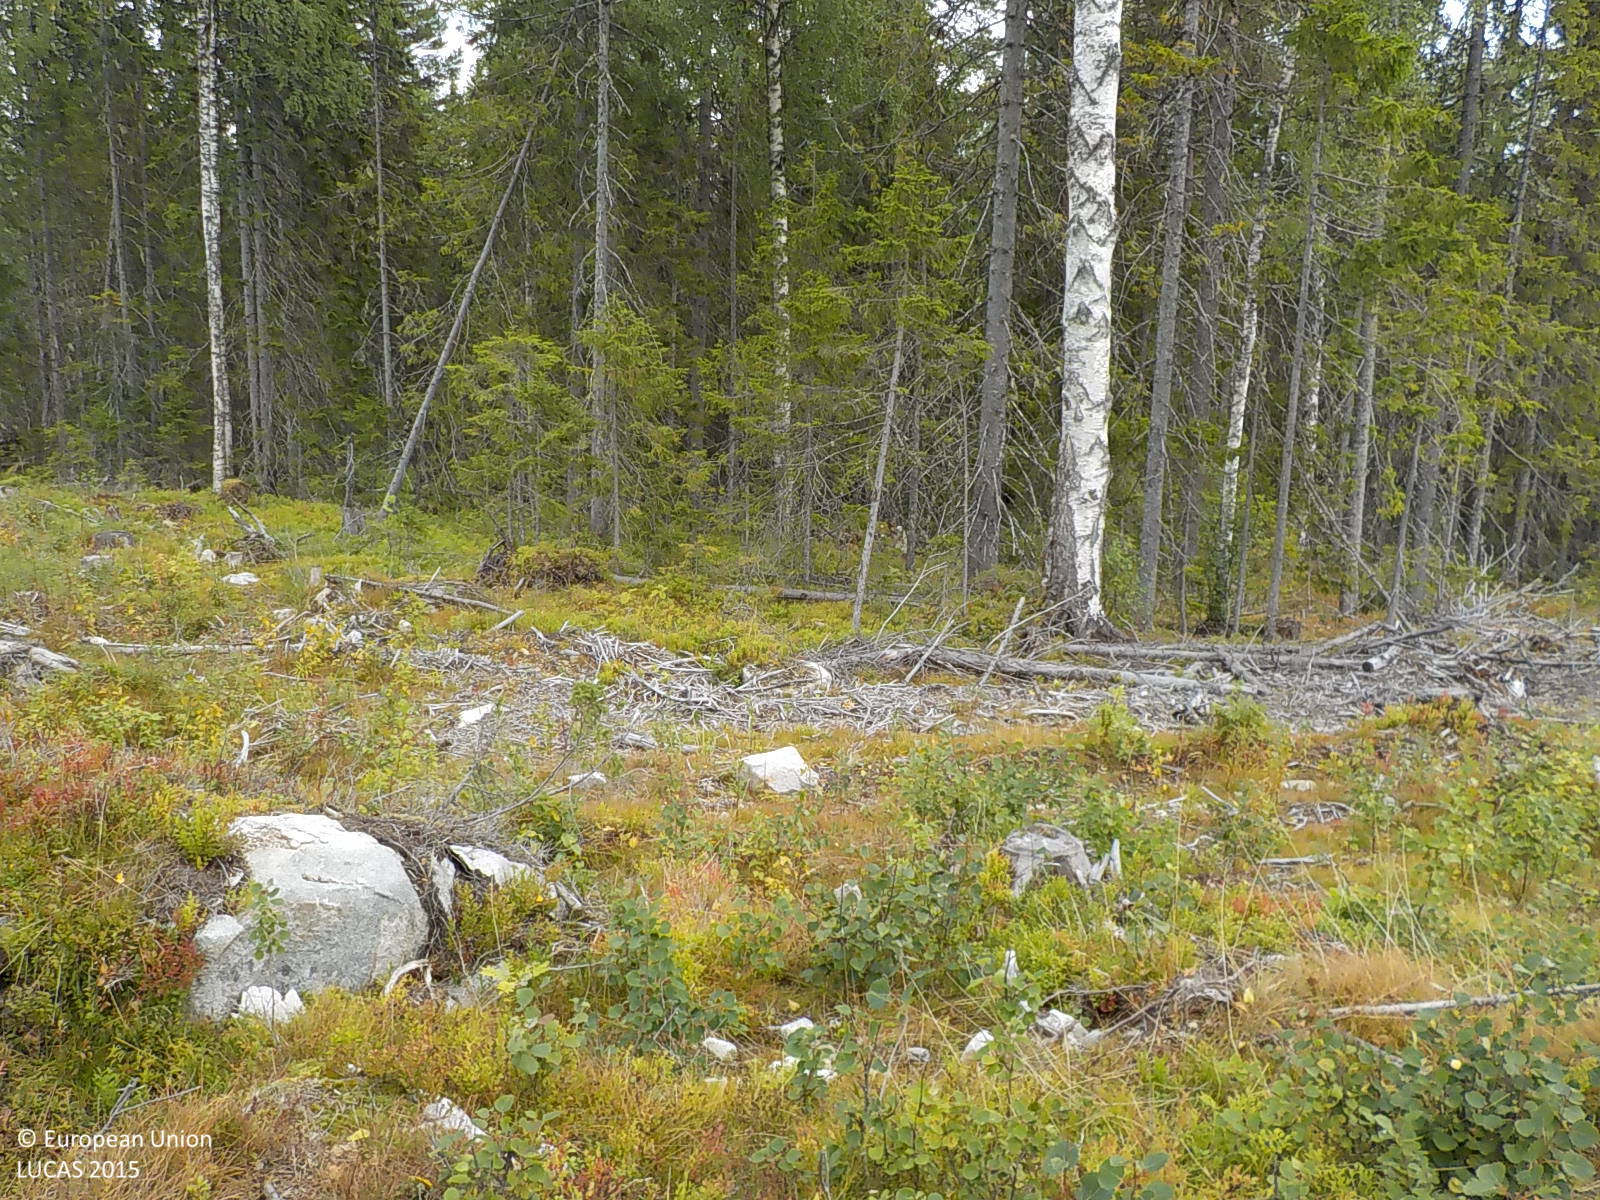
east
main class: Woodland
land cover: Spruce dominated coniferous woodland
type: boreal forest
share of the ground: 10 - 25 %
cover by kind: shrubs 30 %, herbaceous plants 30 %, coniferous forest trees 20 %, lichens and mosses 15 %, broadleaved forest trees 5 %
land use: Forestry
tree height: < 5 m
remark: Clear cut
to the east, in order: Spruce dominated coniferous woodland; Tracks; Spruce dominated mixed woodland; Spruce dominated coniferous woodland; Spruce dominated mixed woodland
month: September
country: SE
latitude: 63.3318
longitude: 17.8640
